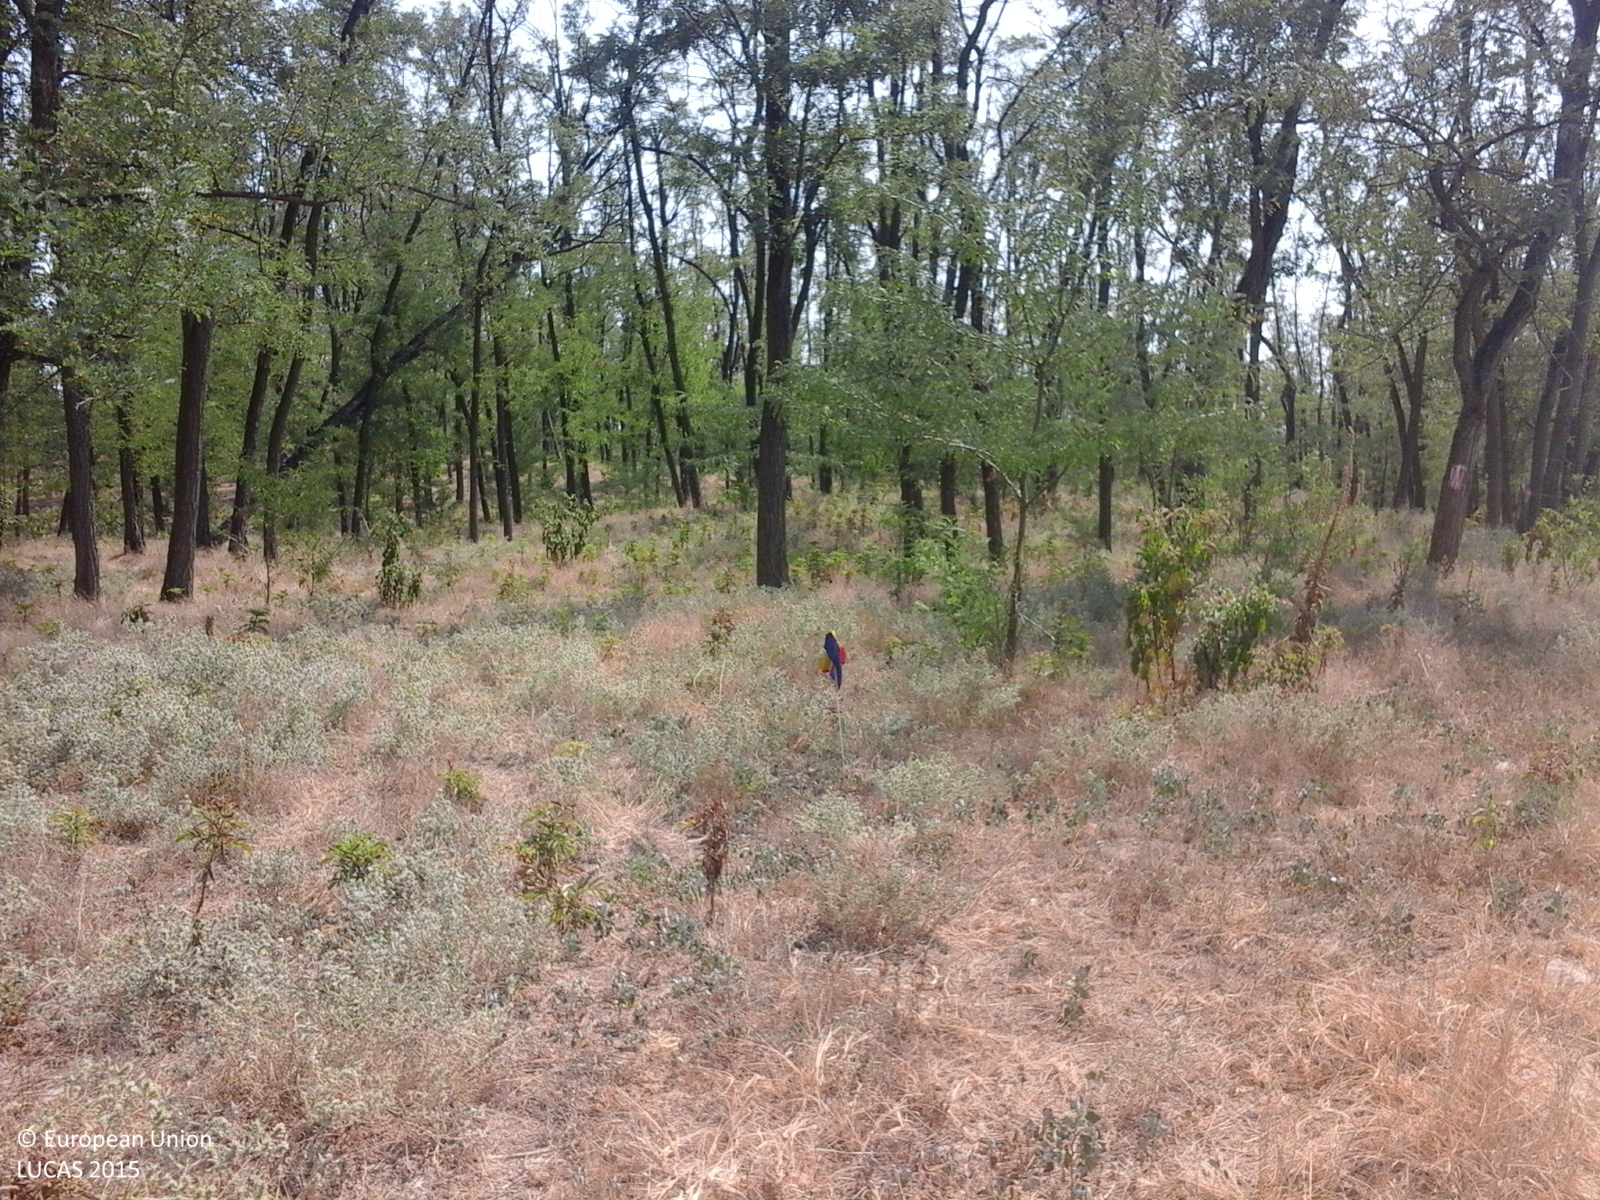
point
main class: Woodland
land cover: Broadleaved woodland
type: exotic forest
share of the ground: > 75 %
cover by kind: broadleaved forest trees 90 %, herbaceous plants 10 %
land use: Forestry
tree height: > 5 m
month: August
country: RO
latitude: 43.8751
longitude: 23.1469
